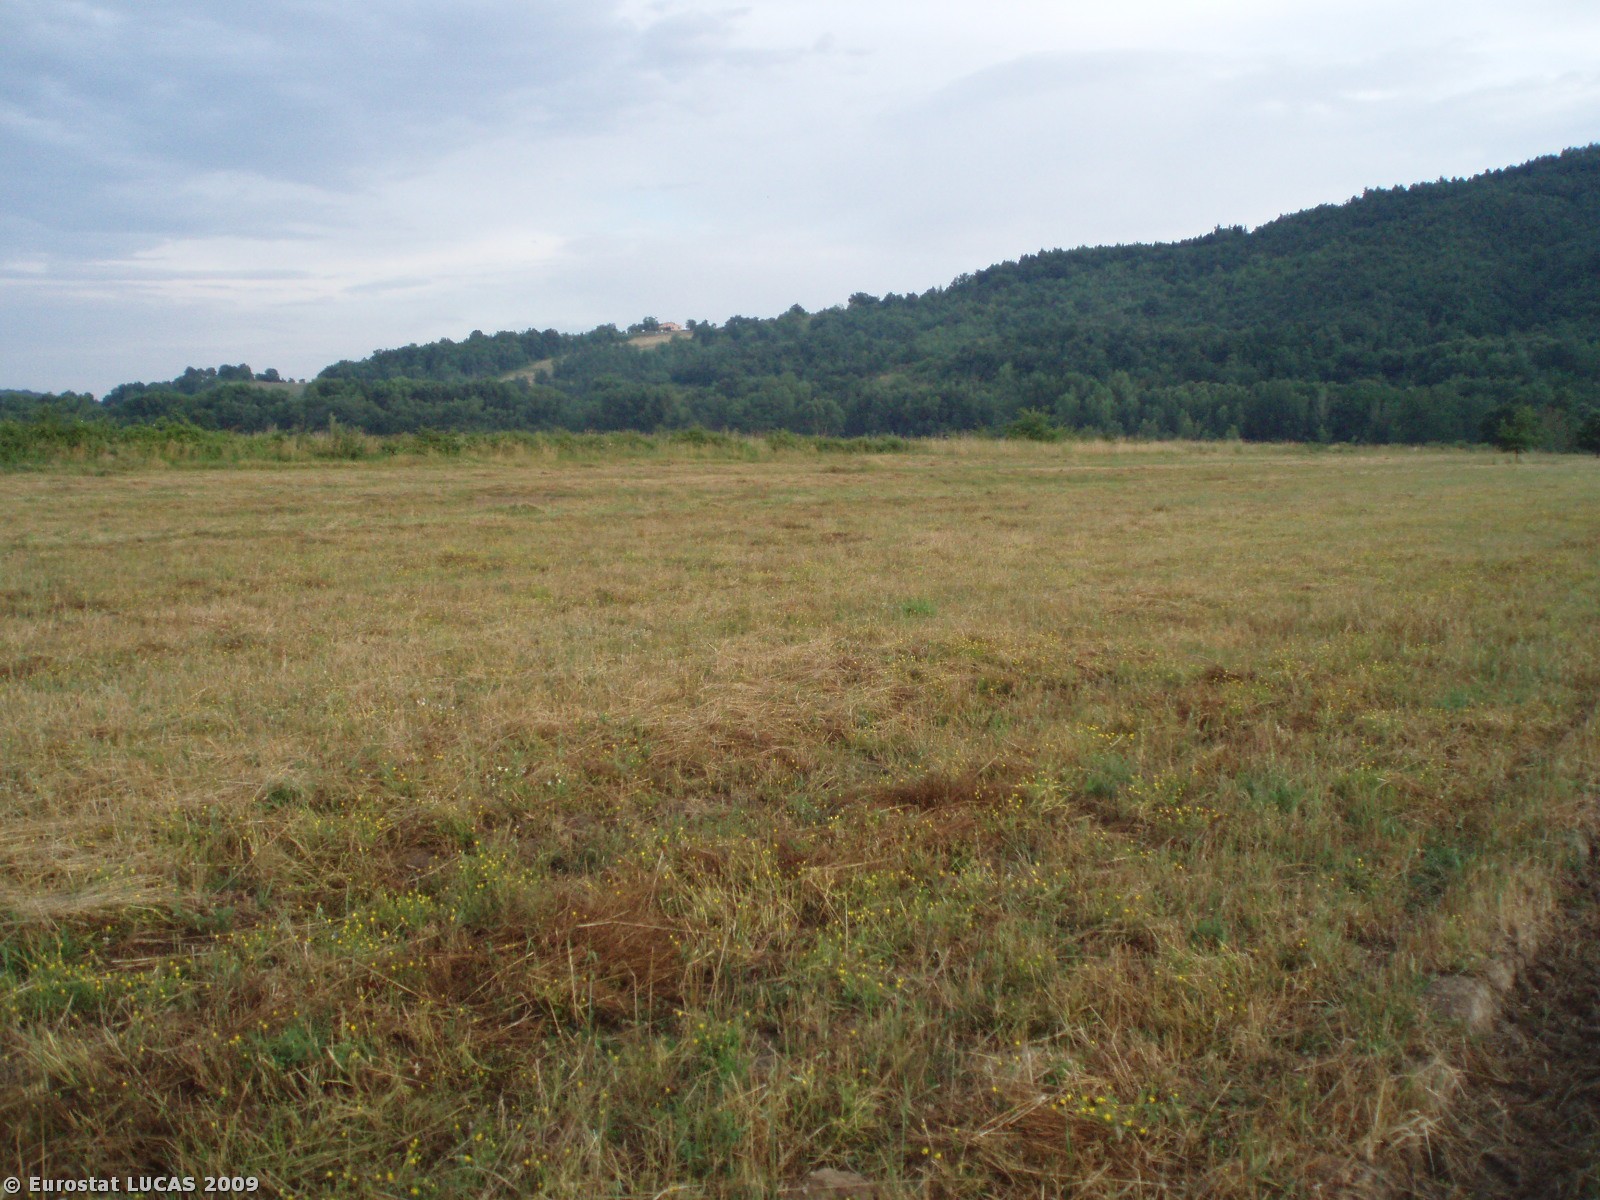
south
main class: Grassland
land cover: Grassland without tree/shrub cover
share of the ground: > 75 %
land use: Agriculture (excluding fallow land and kitchen gardens)
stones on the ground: < 10 %
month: June
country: IT
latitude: 42.6054
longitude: 11.5914
